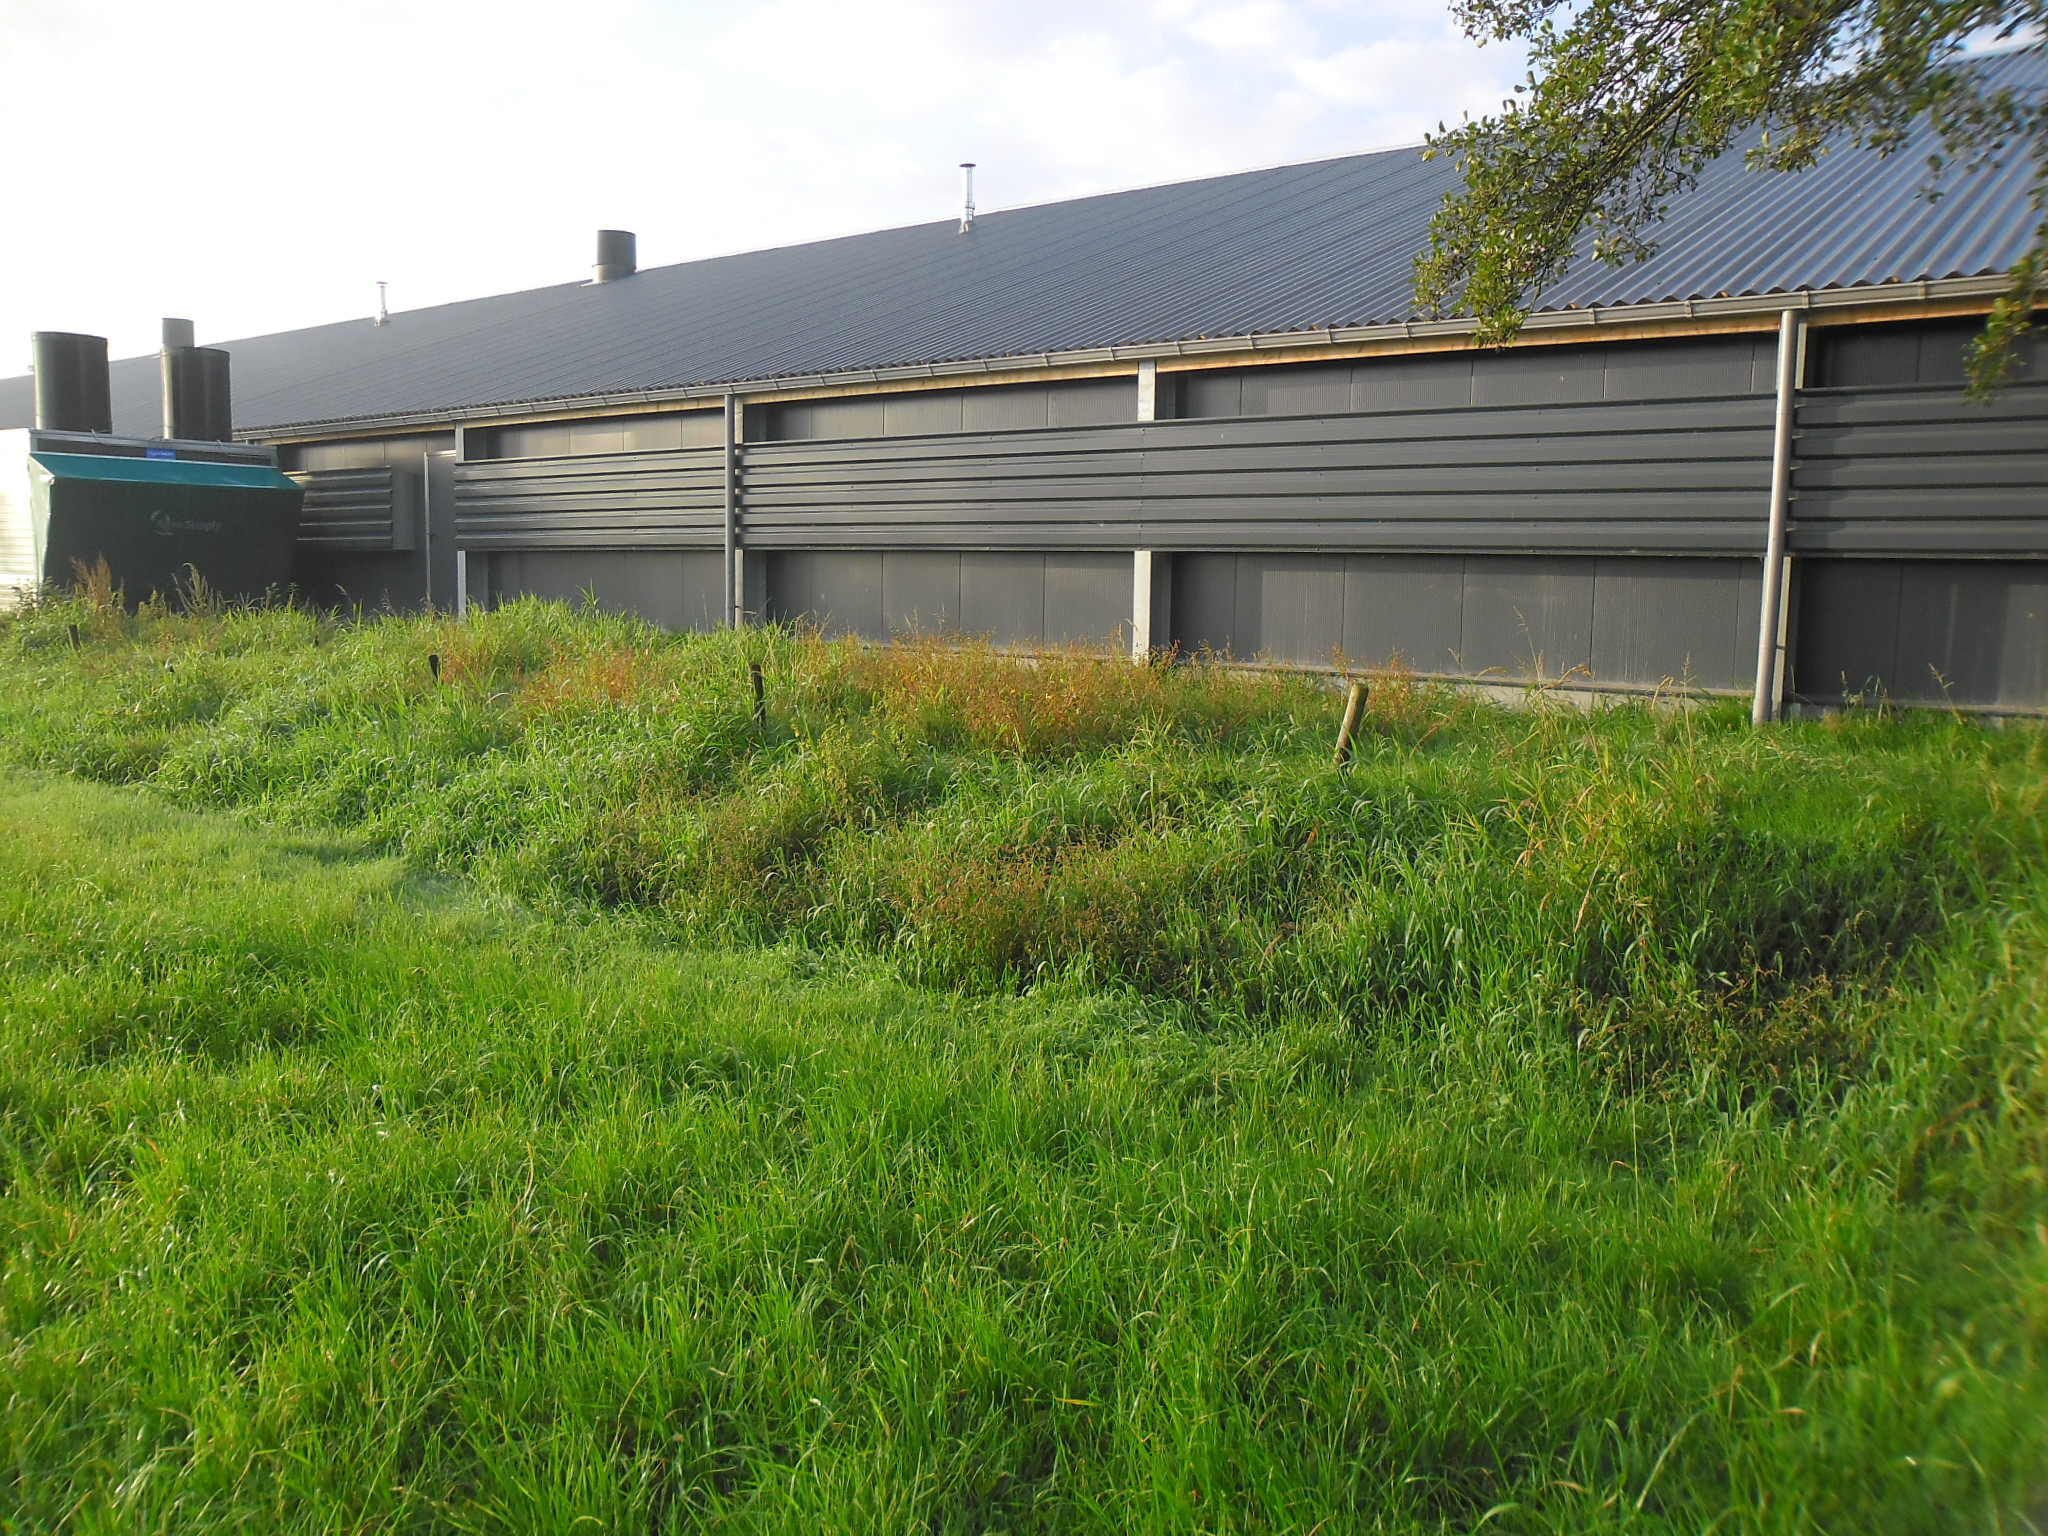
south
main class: Grassland
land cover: Grassland without tree/shrub cover
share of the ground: > 75 %
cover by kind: herbaceous plants 100 %
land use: Agriculture (excluding fallow land and kitchen gardens)
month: September
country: NL
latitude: 52.0590
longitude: 5.5207
